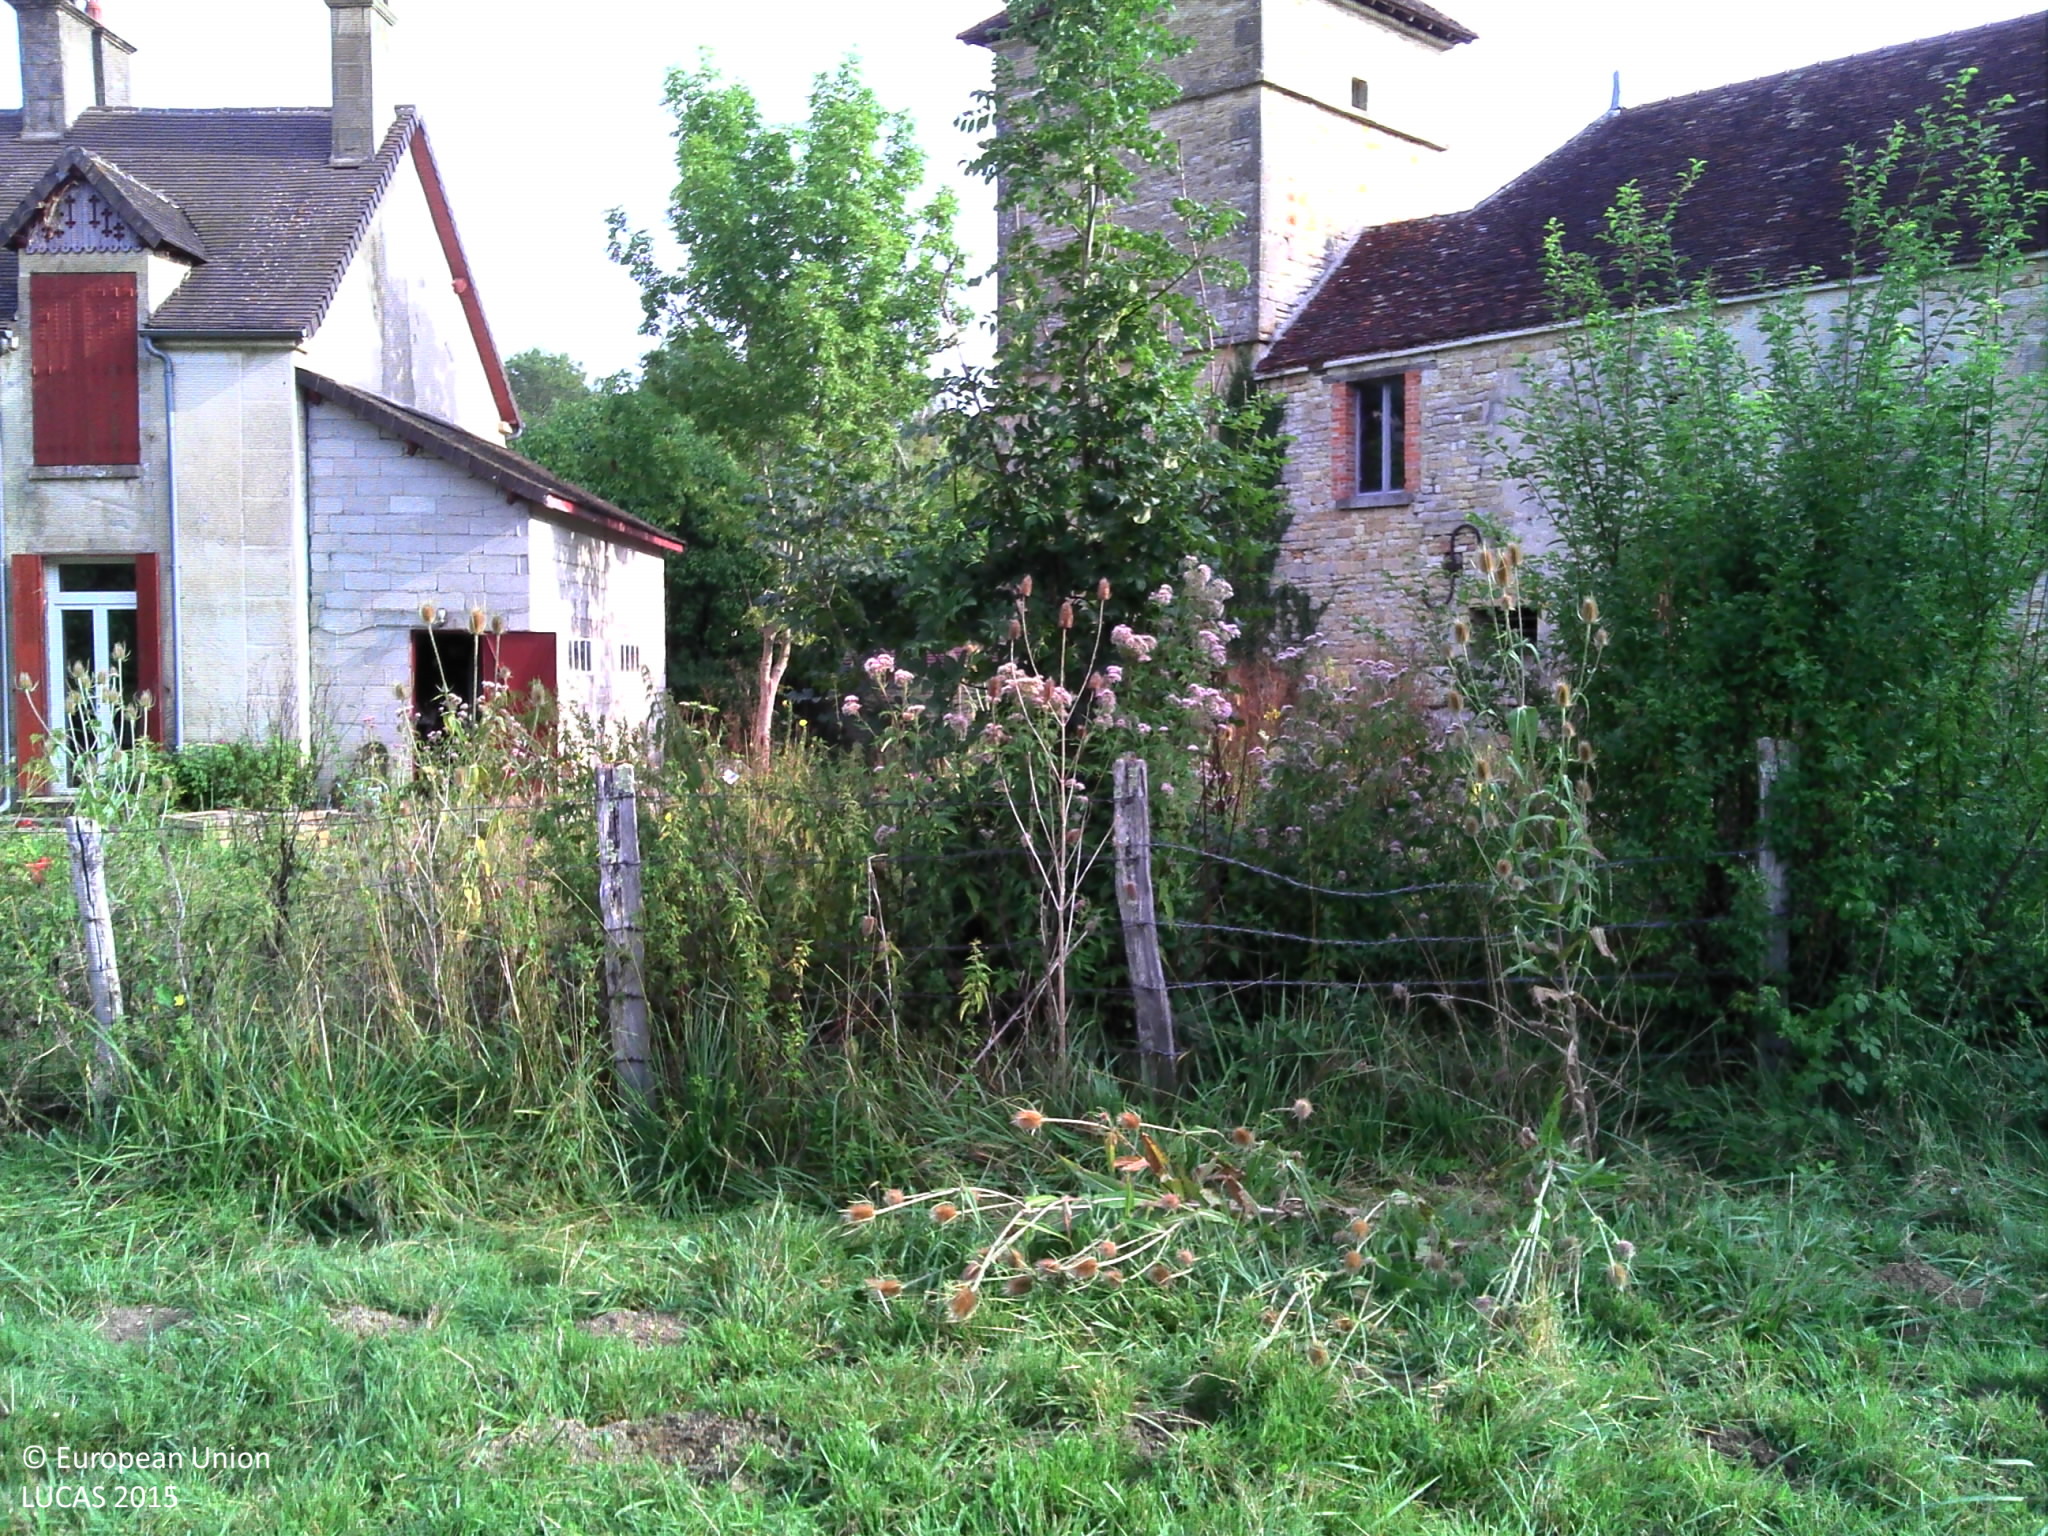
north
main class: Grassland
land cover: Grassland without tree/shrub cover
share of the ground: > 75 %
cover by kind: herbaceous plants 100 %
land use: Agriculture (excluding fallow land and kitchen gardens)
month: August
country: FR
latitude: 47.8426
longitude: 4.3190
